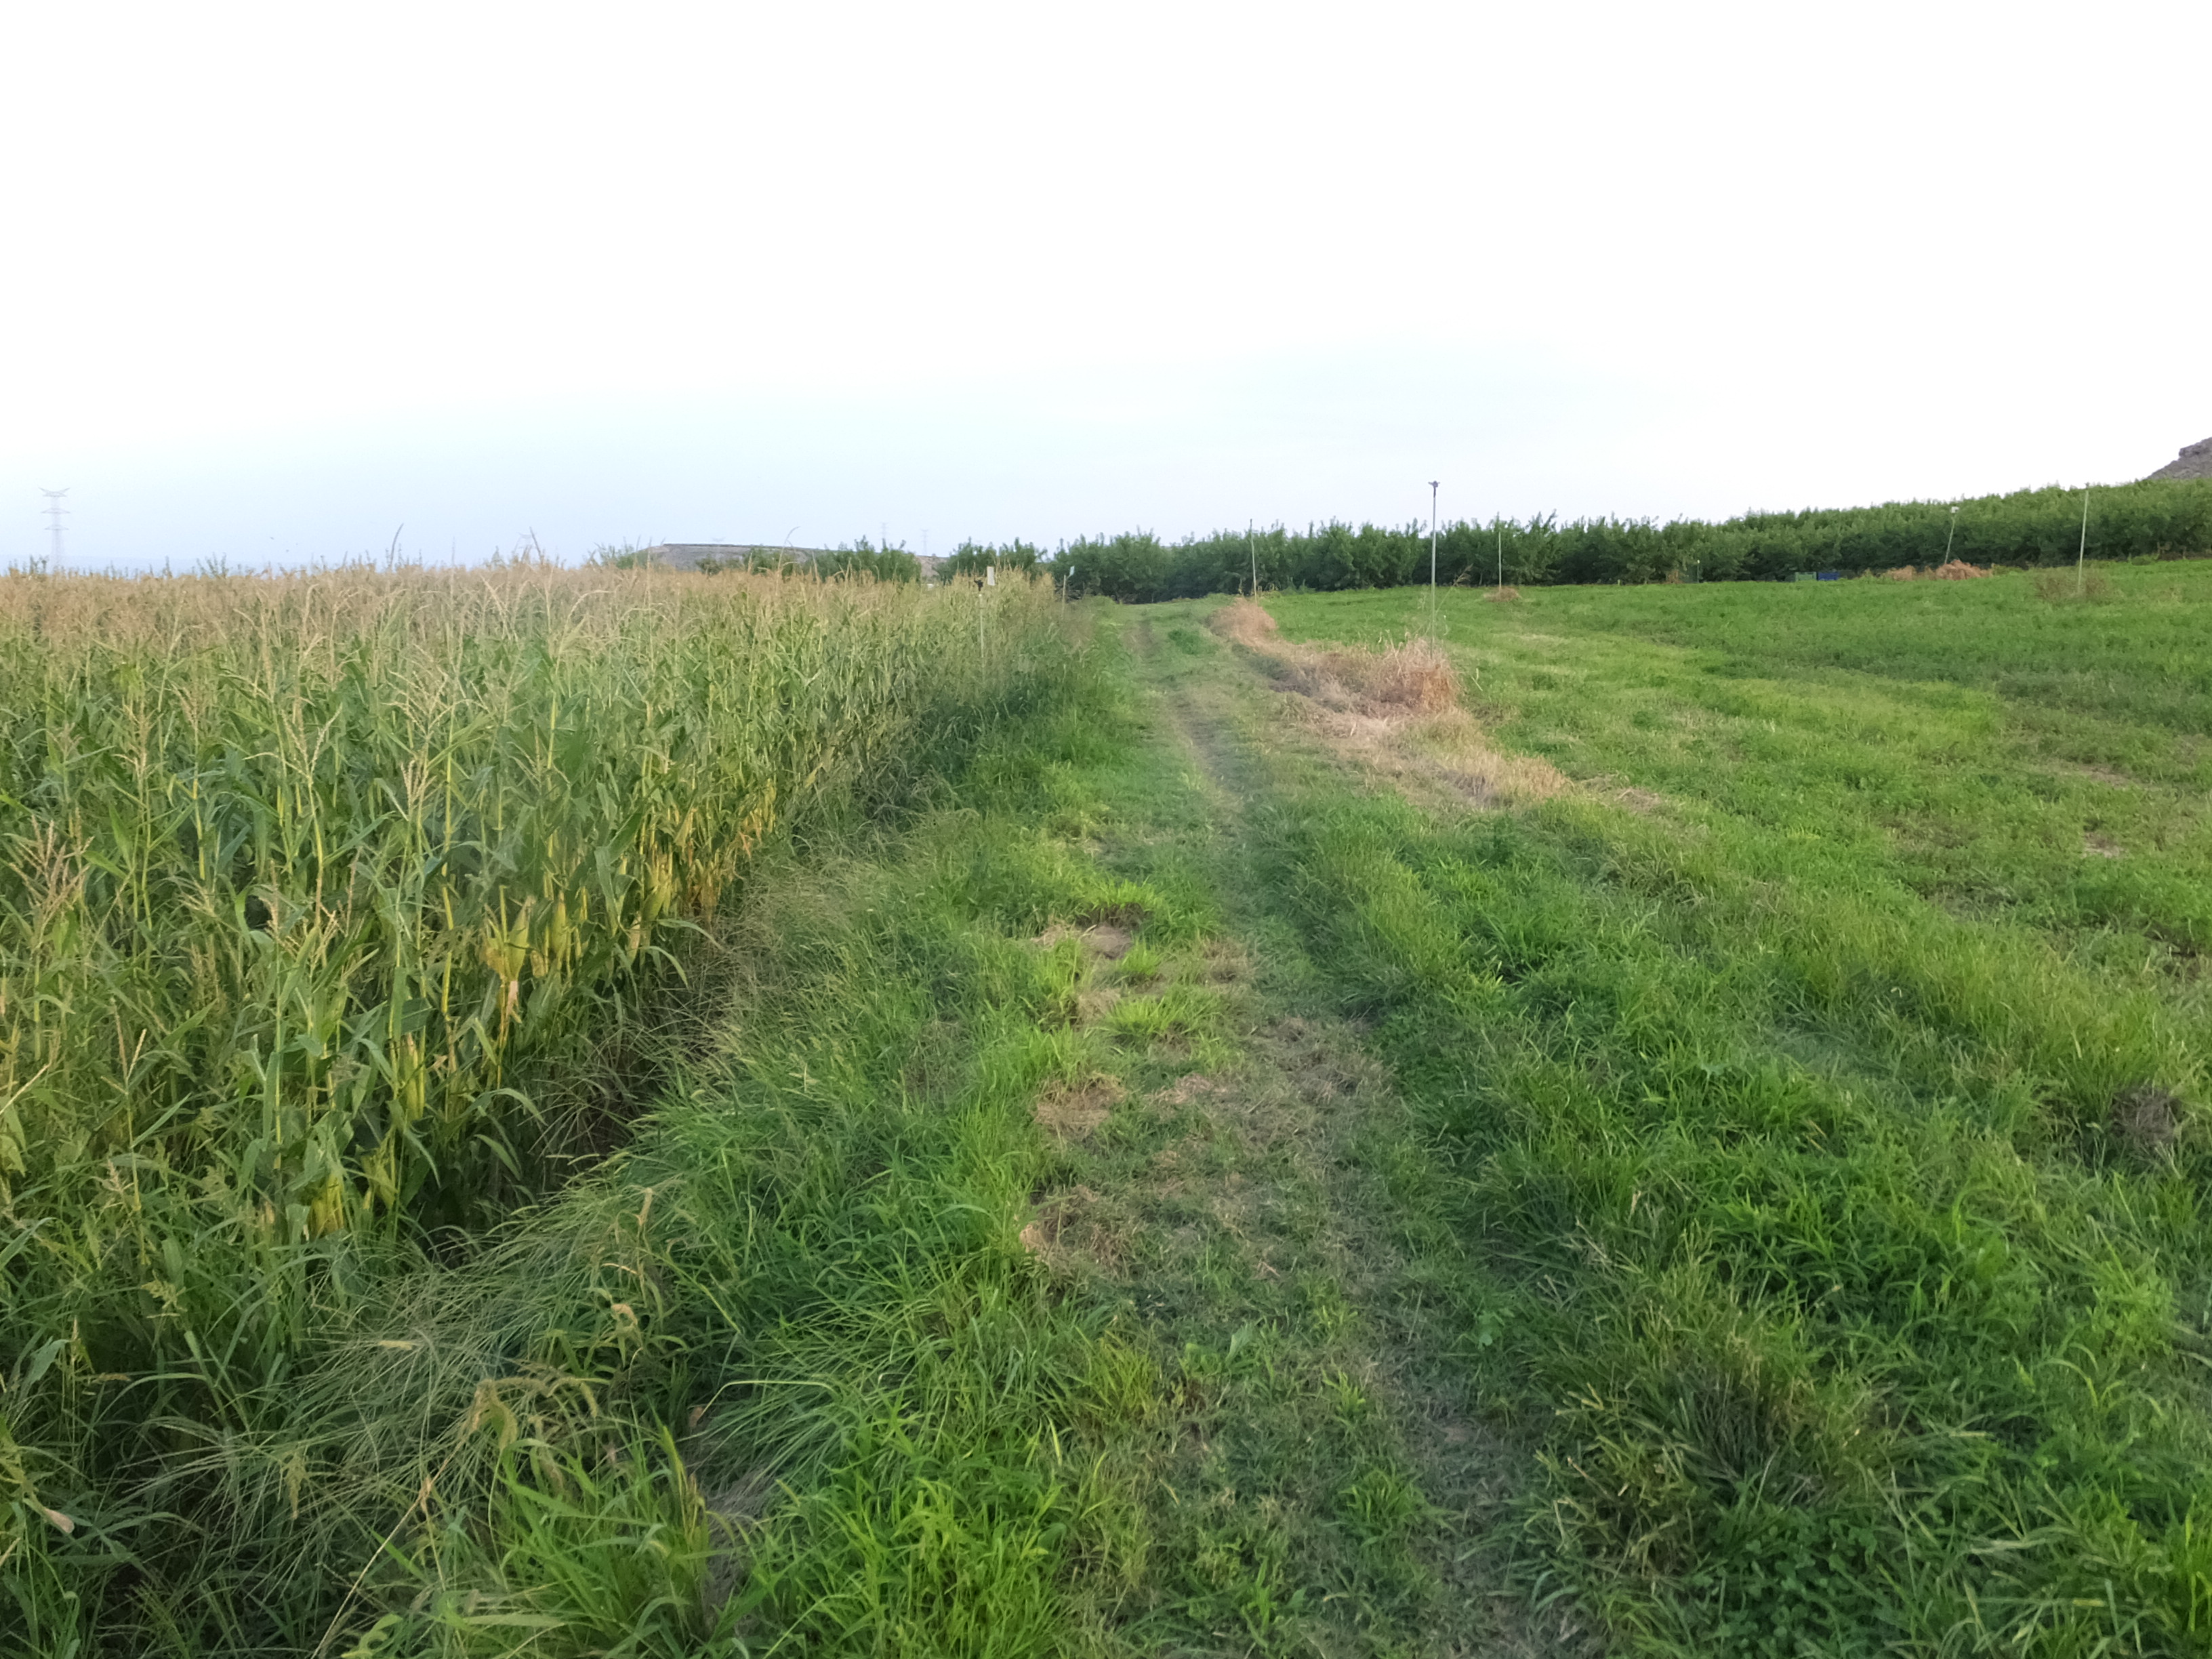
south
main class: Cropland
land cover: Maize
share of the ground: > 75 %
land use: Agriculture (excluding fallow land and kitchen gardens)
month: August
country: ES
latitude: 41.5839
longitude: 0.4511
